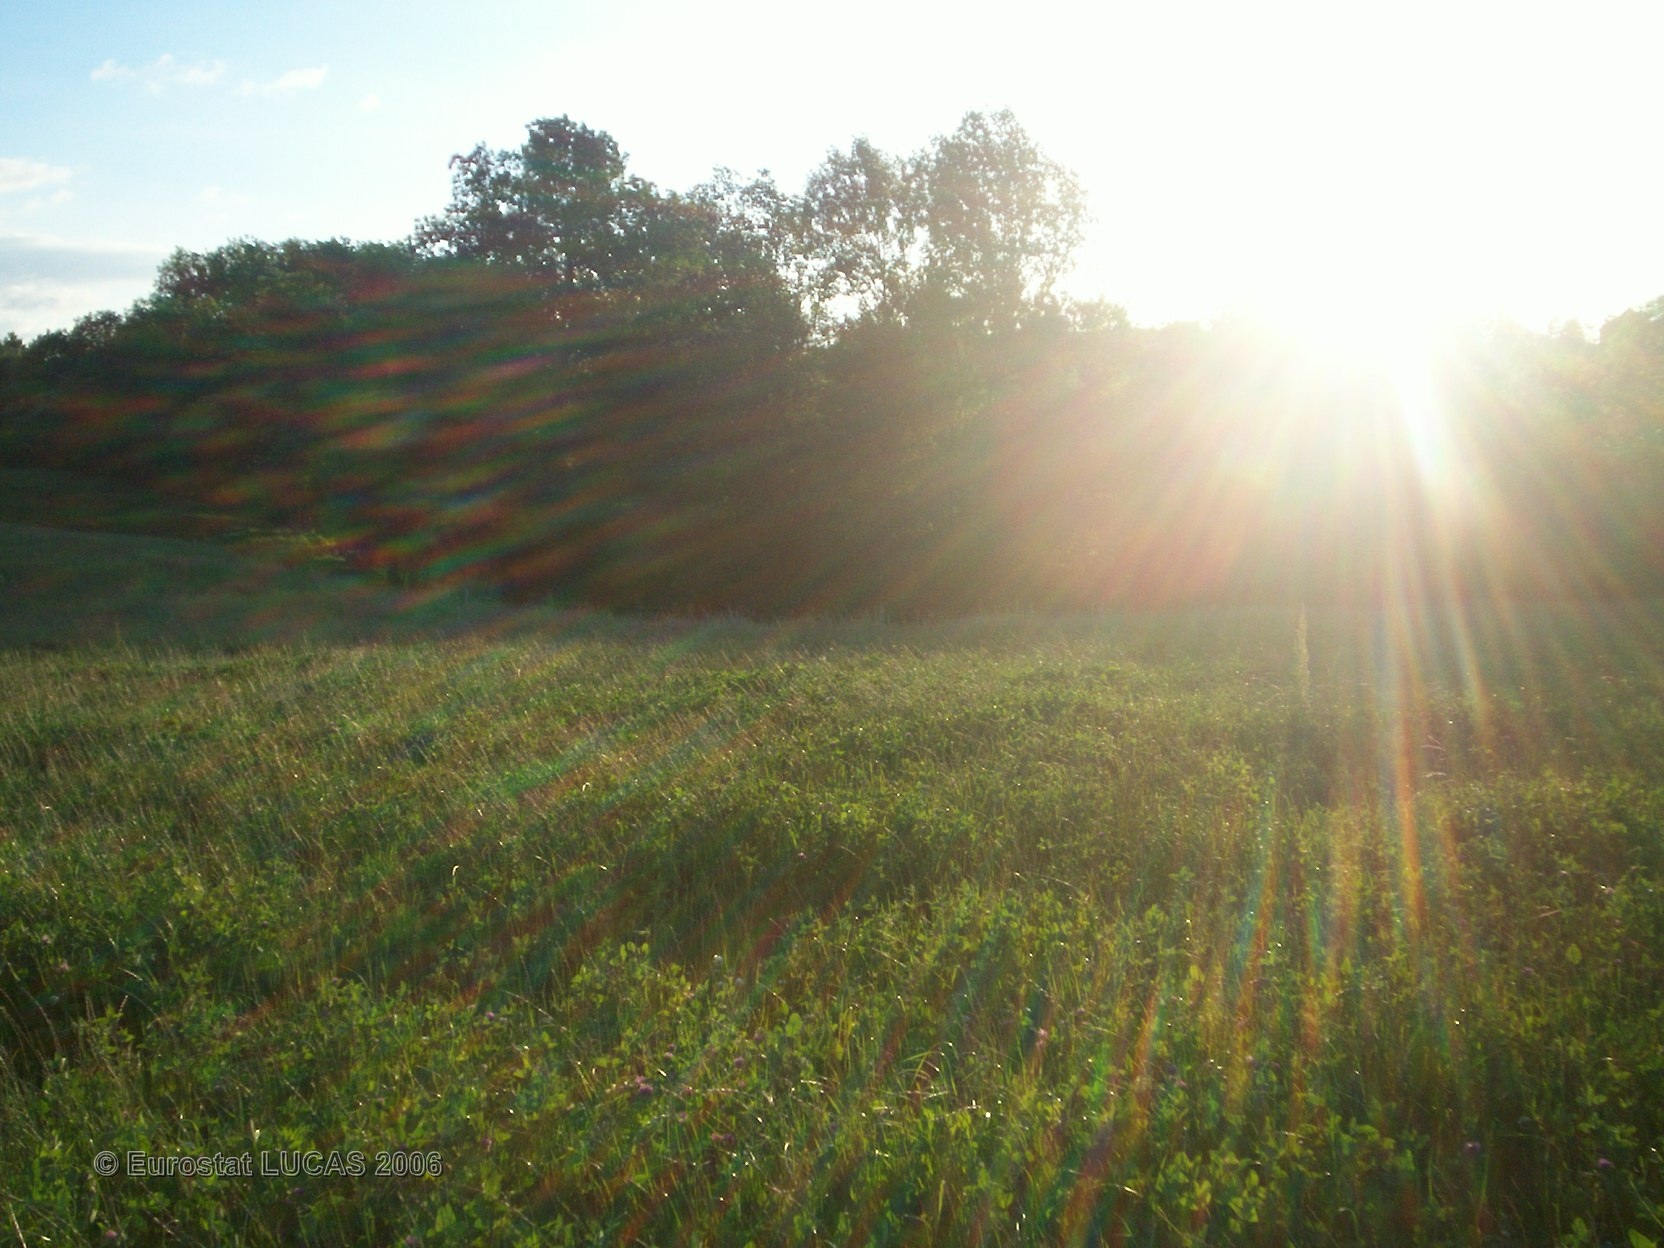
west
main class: Cropland
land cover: Other leguminous and mixtures for fodder
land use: Agriculture (excluding fallow land and kitchen gardens)
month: June
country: FR
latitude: 46.0762
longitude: 3.1330
